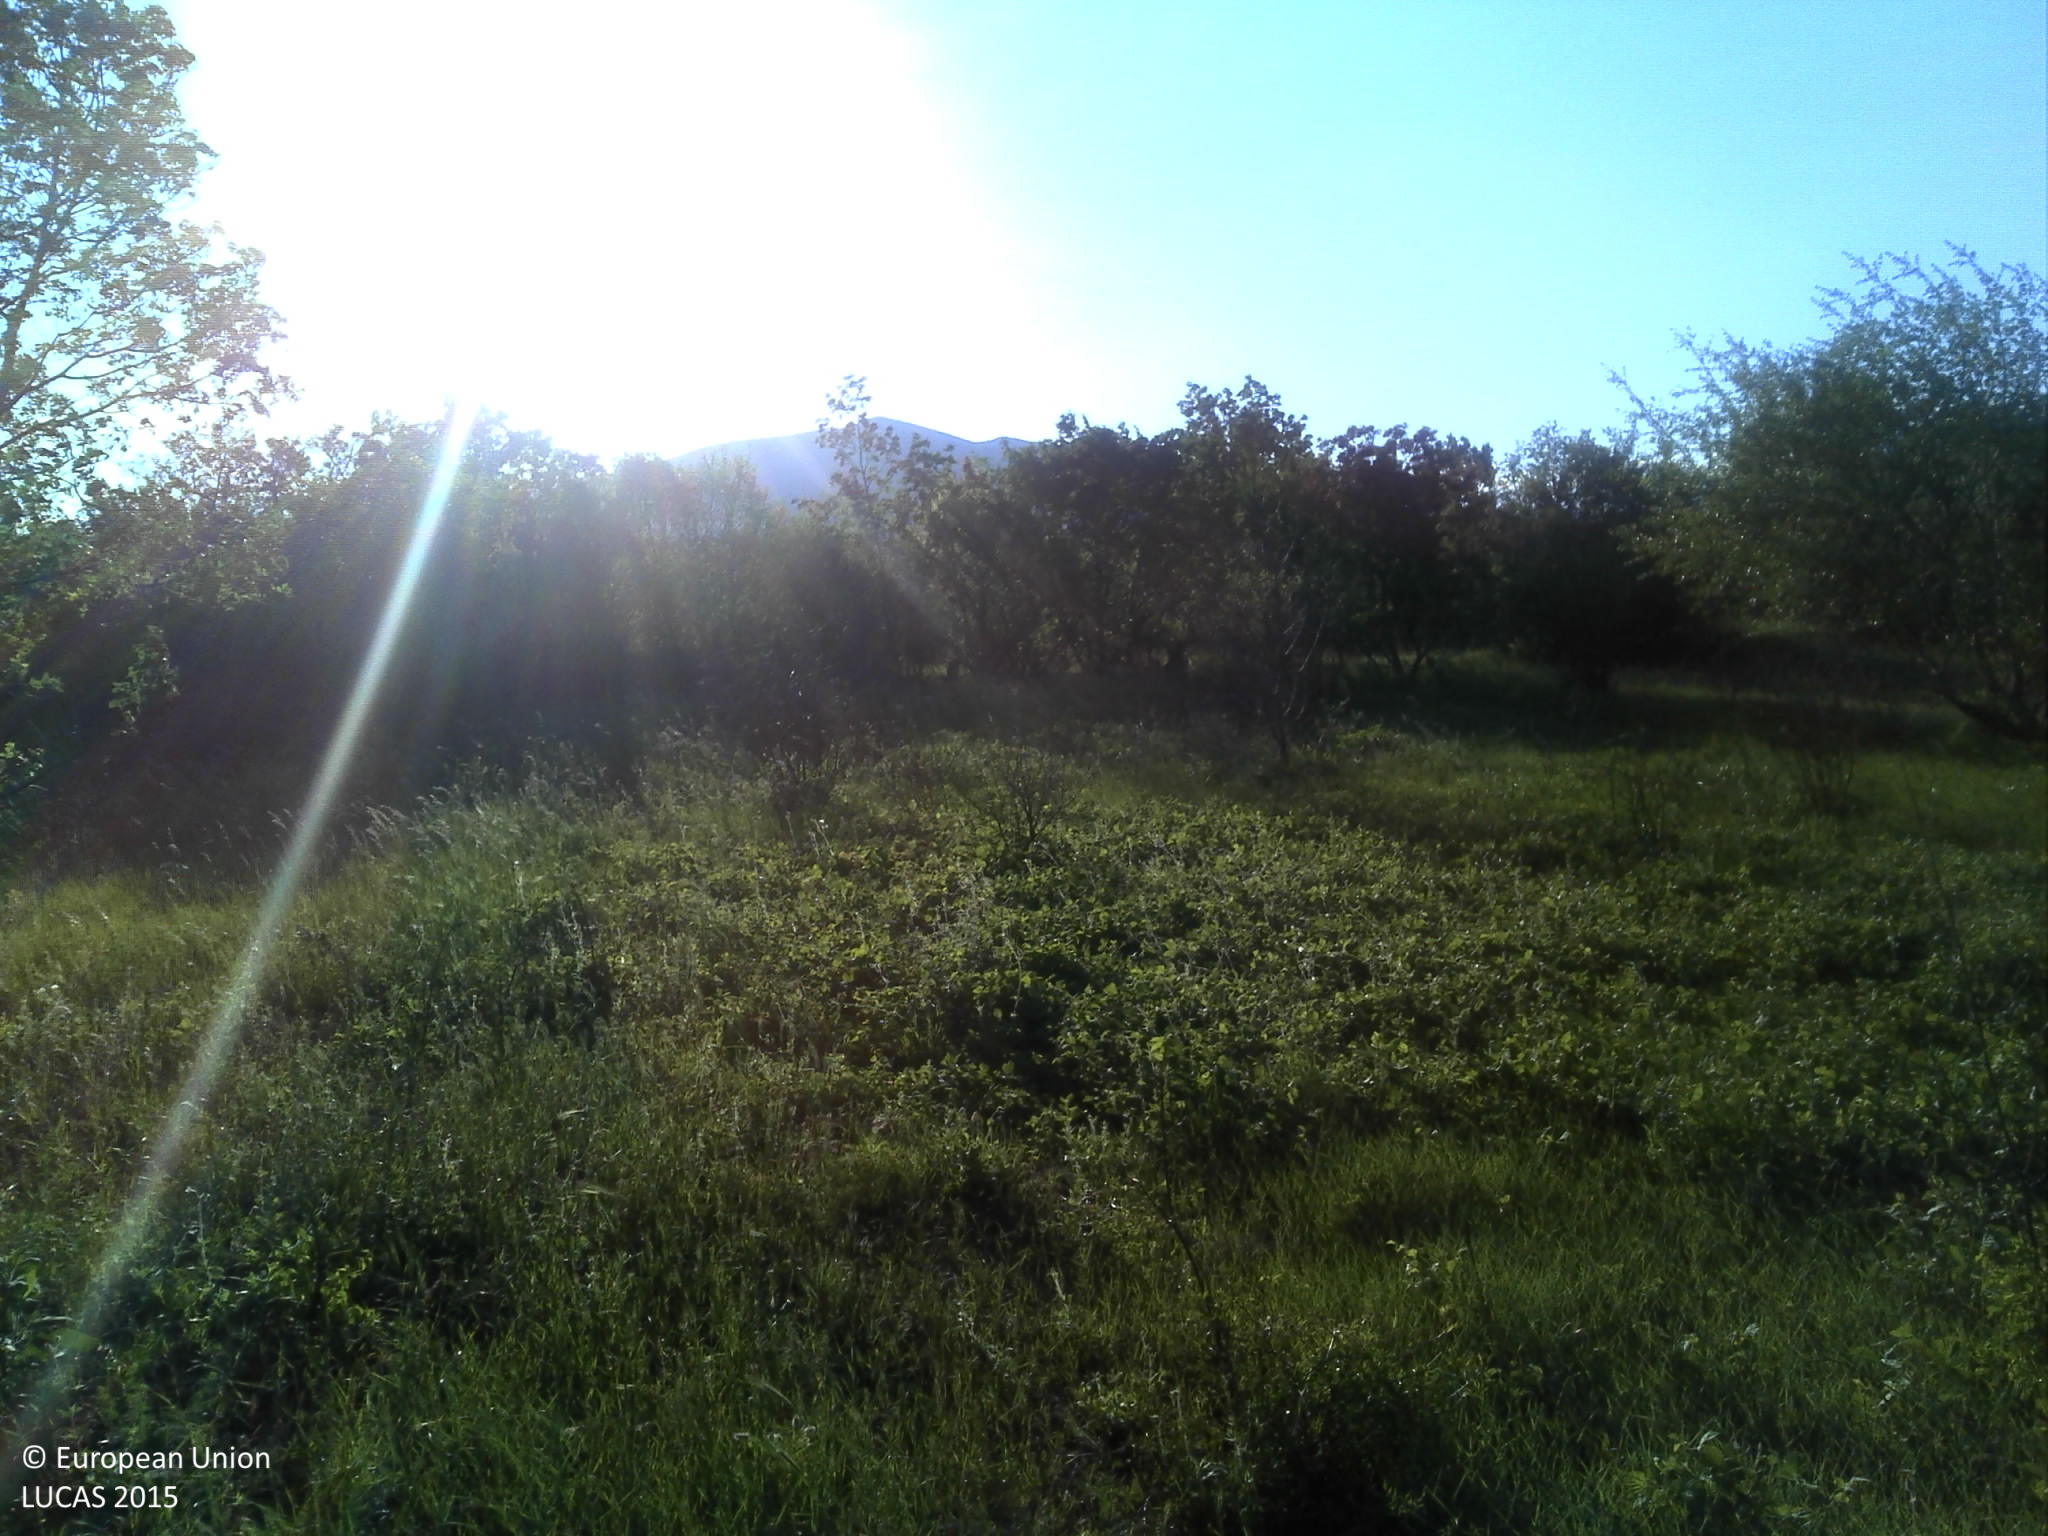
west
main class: Grassland
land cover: Grassland with sparse tree/shrub cover
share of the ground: 10 - 25 %
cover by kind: herbaceous plants 85 %, shrubs 10 %, broadleaved forest trees 5 %
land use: Semi-natural and natural areas not in use
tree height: < 5 m
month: May
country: HR
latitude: 44.1166
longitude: 16.1029
